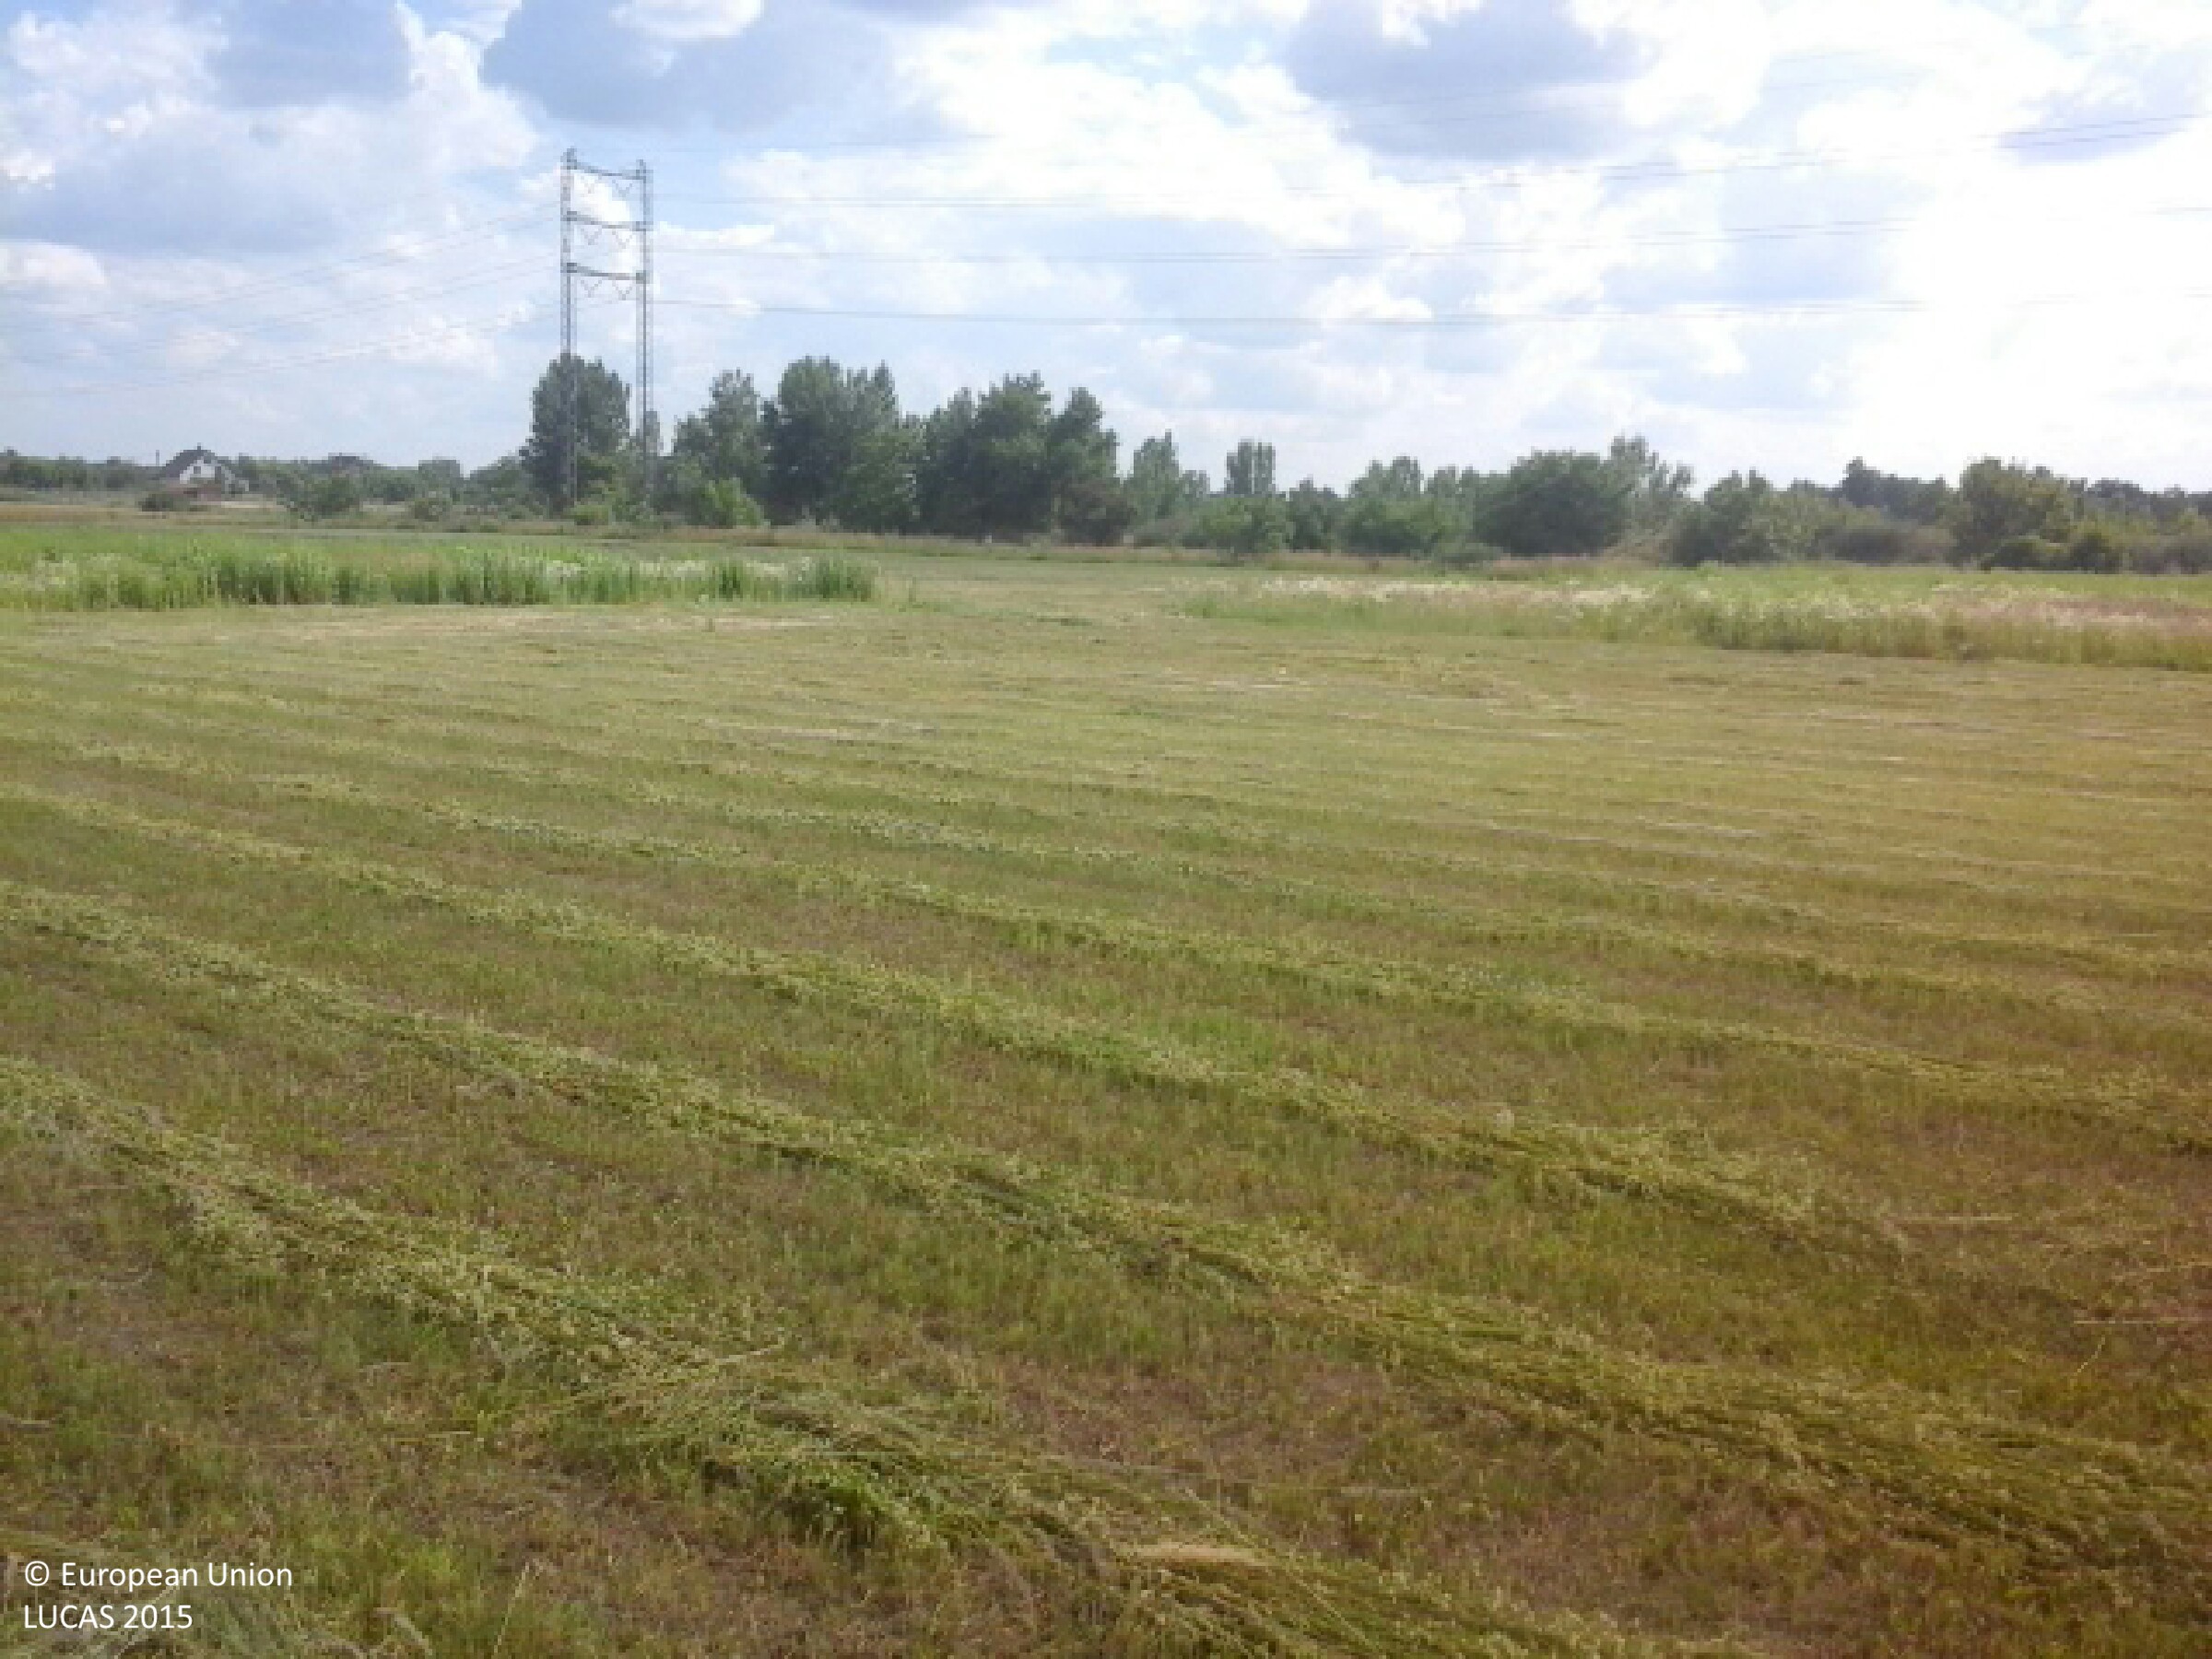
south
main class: Grassland
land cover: Grassland without tree/shrub cover
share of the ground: > 75 %
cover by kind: herbaceous plants 100 %
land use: Agriculture (excluding fallow land and kitchen gardens)
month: June
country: HU
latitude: 47.3966
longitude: 19.0668
